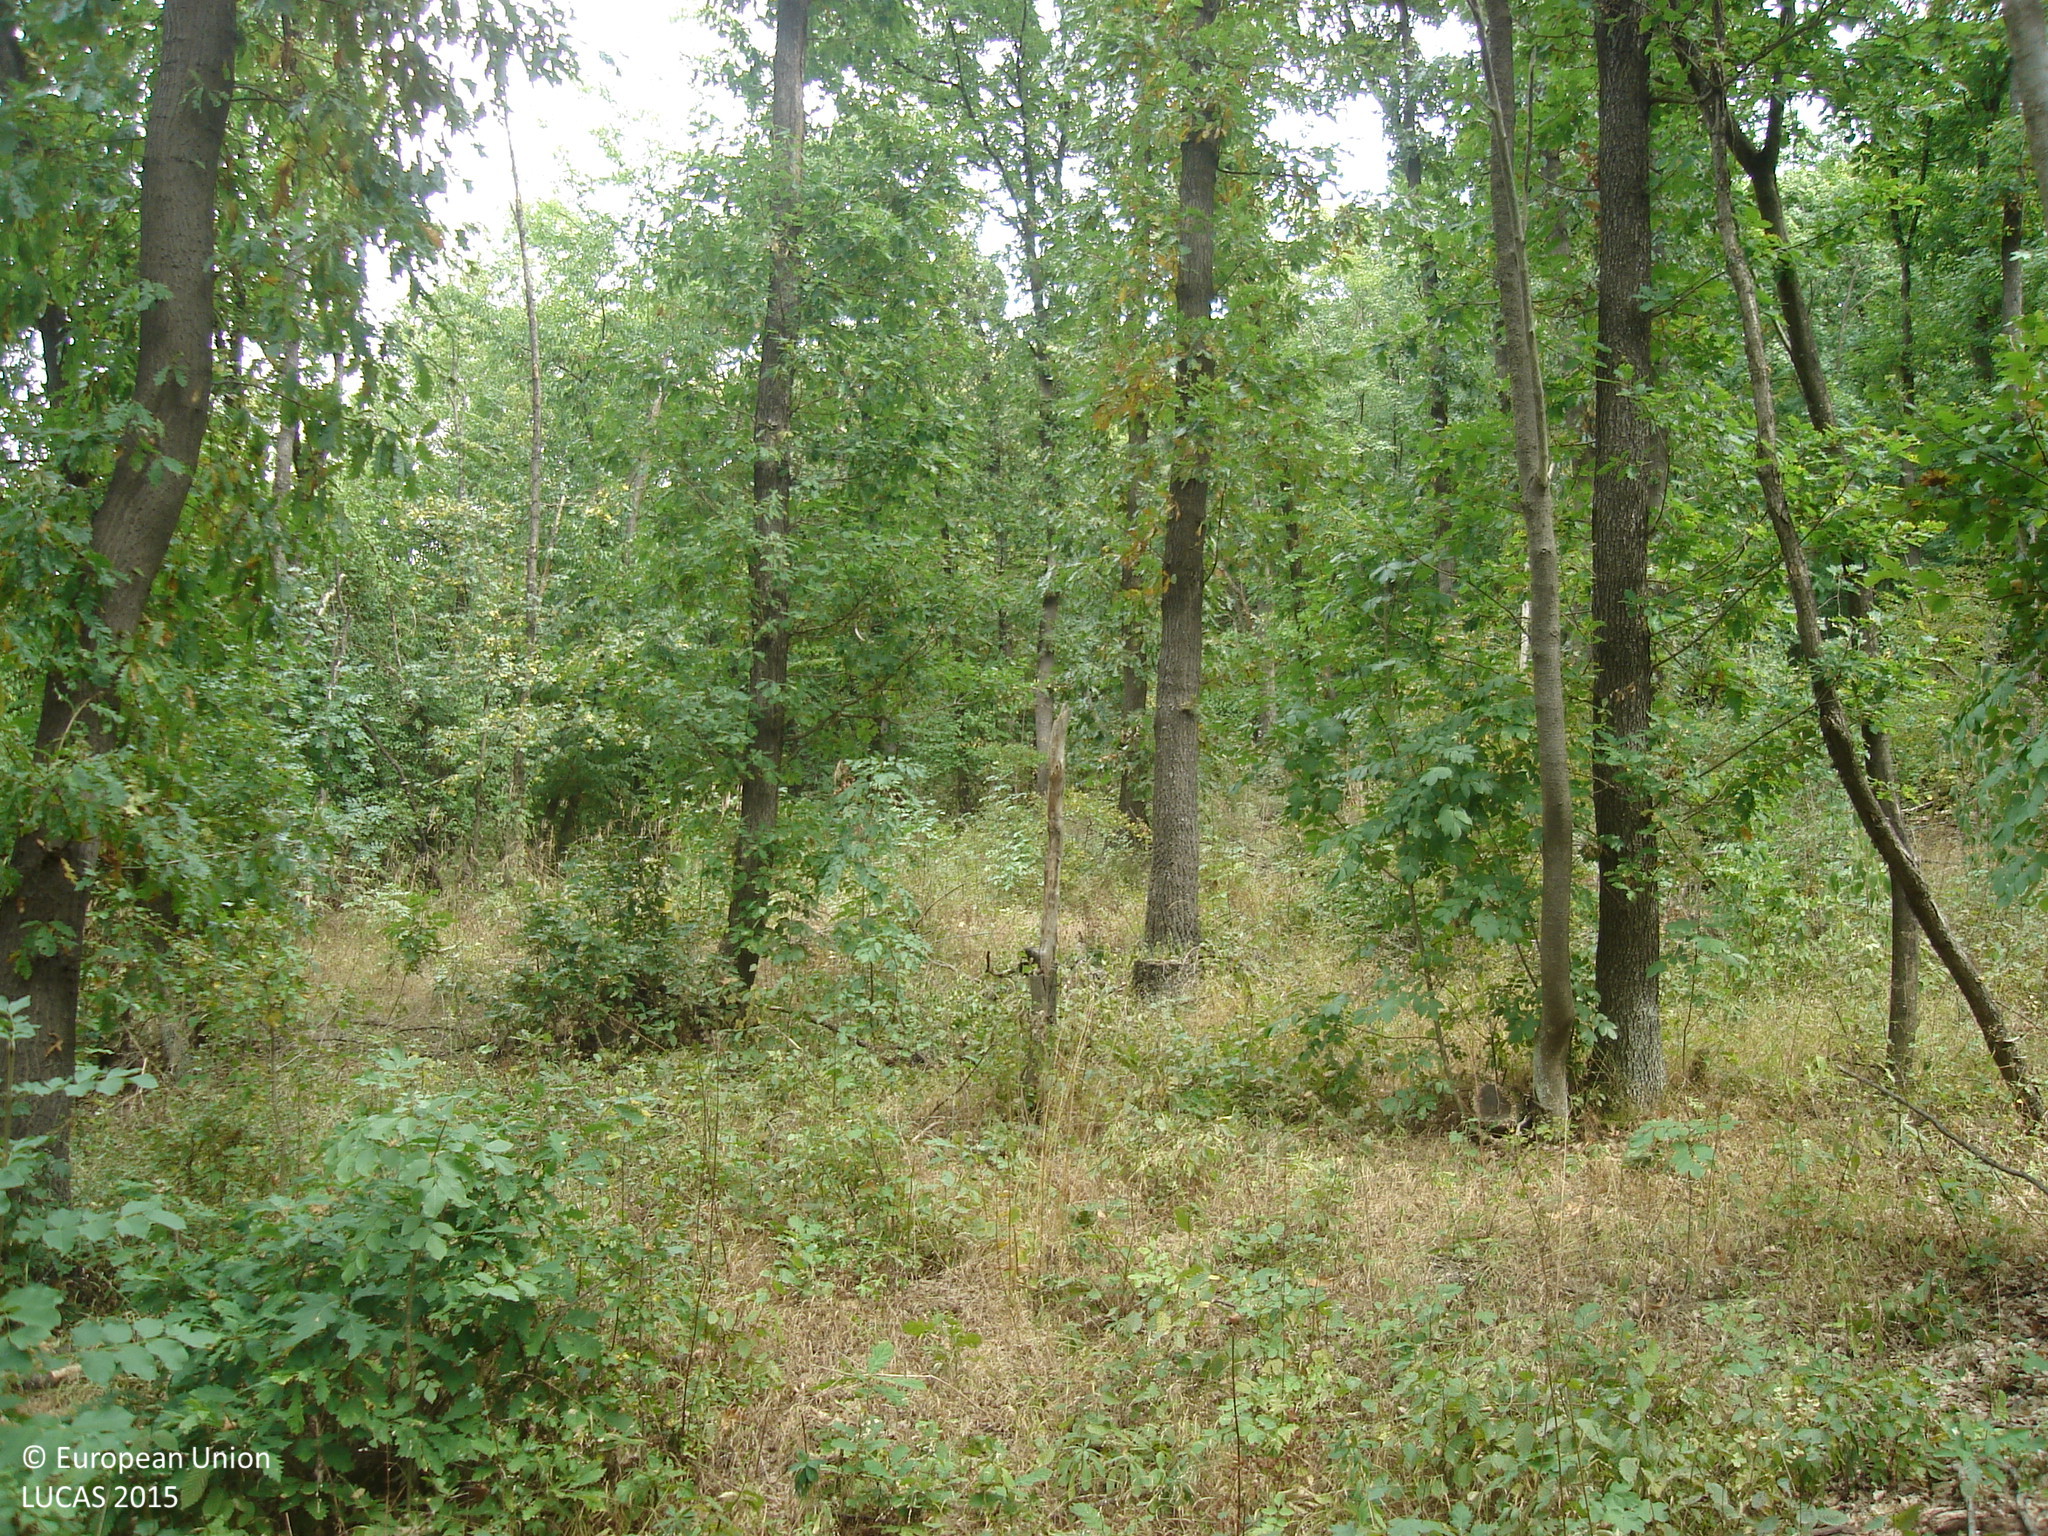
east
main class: Woodland
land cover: Broadleaved woodland
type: acidophilous oak and oak-birch forest
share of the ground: 50 - 75 %
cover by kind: broadleaved forest trees 60 %, shrubs 20 %, herbaceous plants 20 %
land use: Forestry
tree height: > 5 m
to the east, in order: Broadleaved woodland
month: September
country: BG
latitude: 42.6438
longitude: 23.8853
